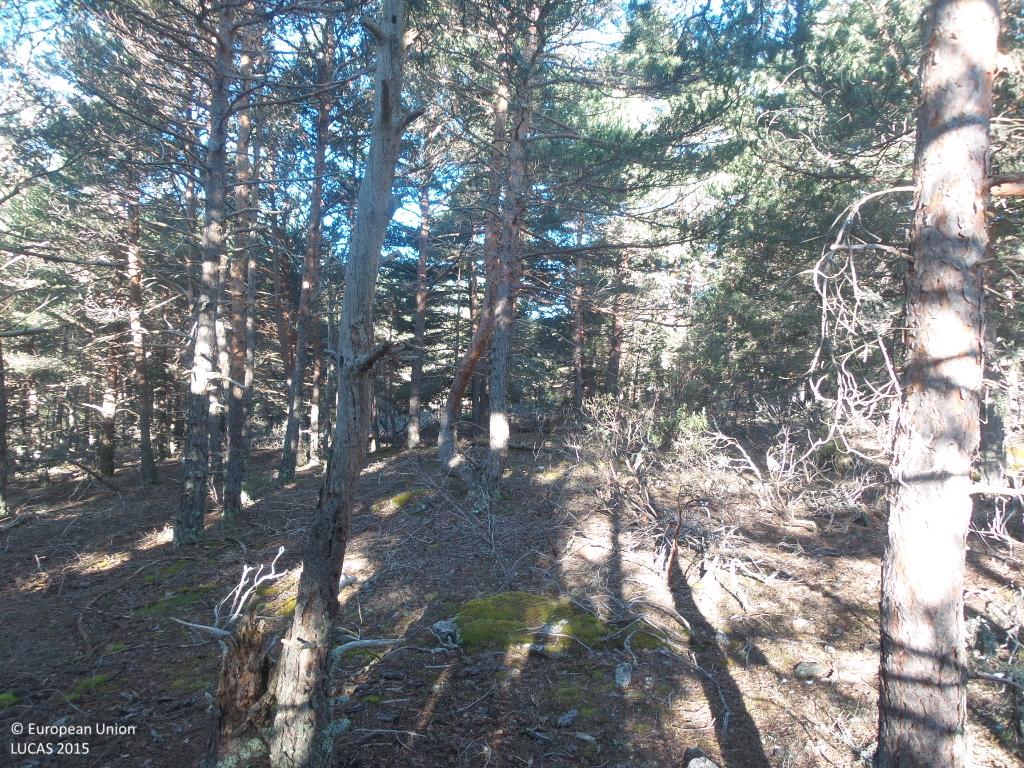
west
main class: Woodland
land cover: Pine dominated coniferous woodland
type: coniferous forest of the mediterranean region
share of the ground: > 75 %
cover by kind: coniferous forest trees 85 %, shrubs 5 %, lichens and mosses 5 %, unconsolidated bare surface 5 %
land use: Forestry
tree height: > 5 m
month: June
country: ES
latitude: 41.1965
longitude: -3.0960
